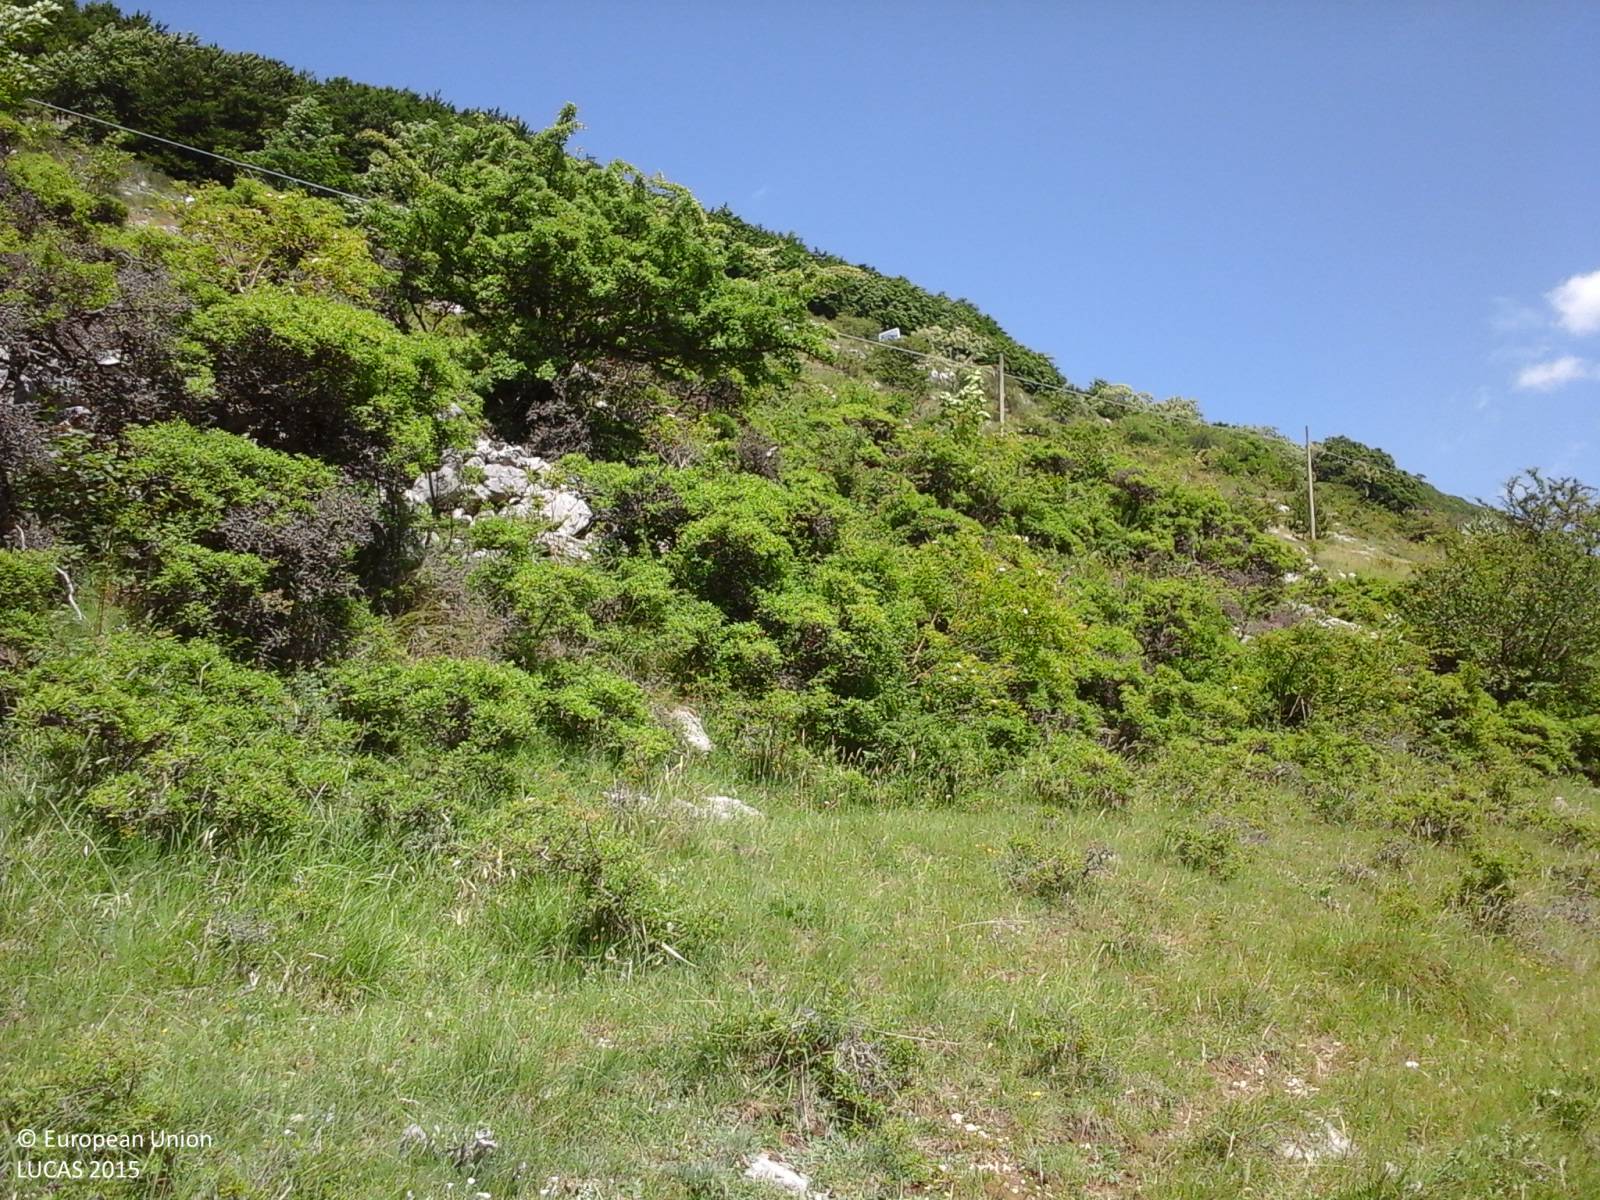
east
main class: Shrubland
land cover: Shrubland with sparse tree cover
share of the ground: > 75 %
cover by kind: herbaceous plants 50 %, shrubs 40 %, broadleaved forest trees 5 %, unconsolidated bare surface 5 %
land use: Agriculture (excluding fallow land and kitchen gardens)
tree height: < 5 m
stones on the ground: 10 - 25 %
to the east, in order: Shrubland with sparse tree cover; Dry stone walls; Shrubland with sparse tree cover; Electric lines; Shrubland with sparse tree cover; Paved roads, cycling and walking lanes; Rock outcrops; Grassland with sparse tree/shrub cover; Rock outcrops; Grassland with sparse tree/shrub cover; Broadleaved woodland
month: June
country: IT
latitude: 42.2537
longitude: 13.3948
